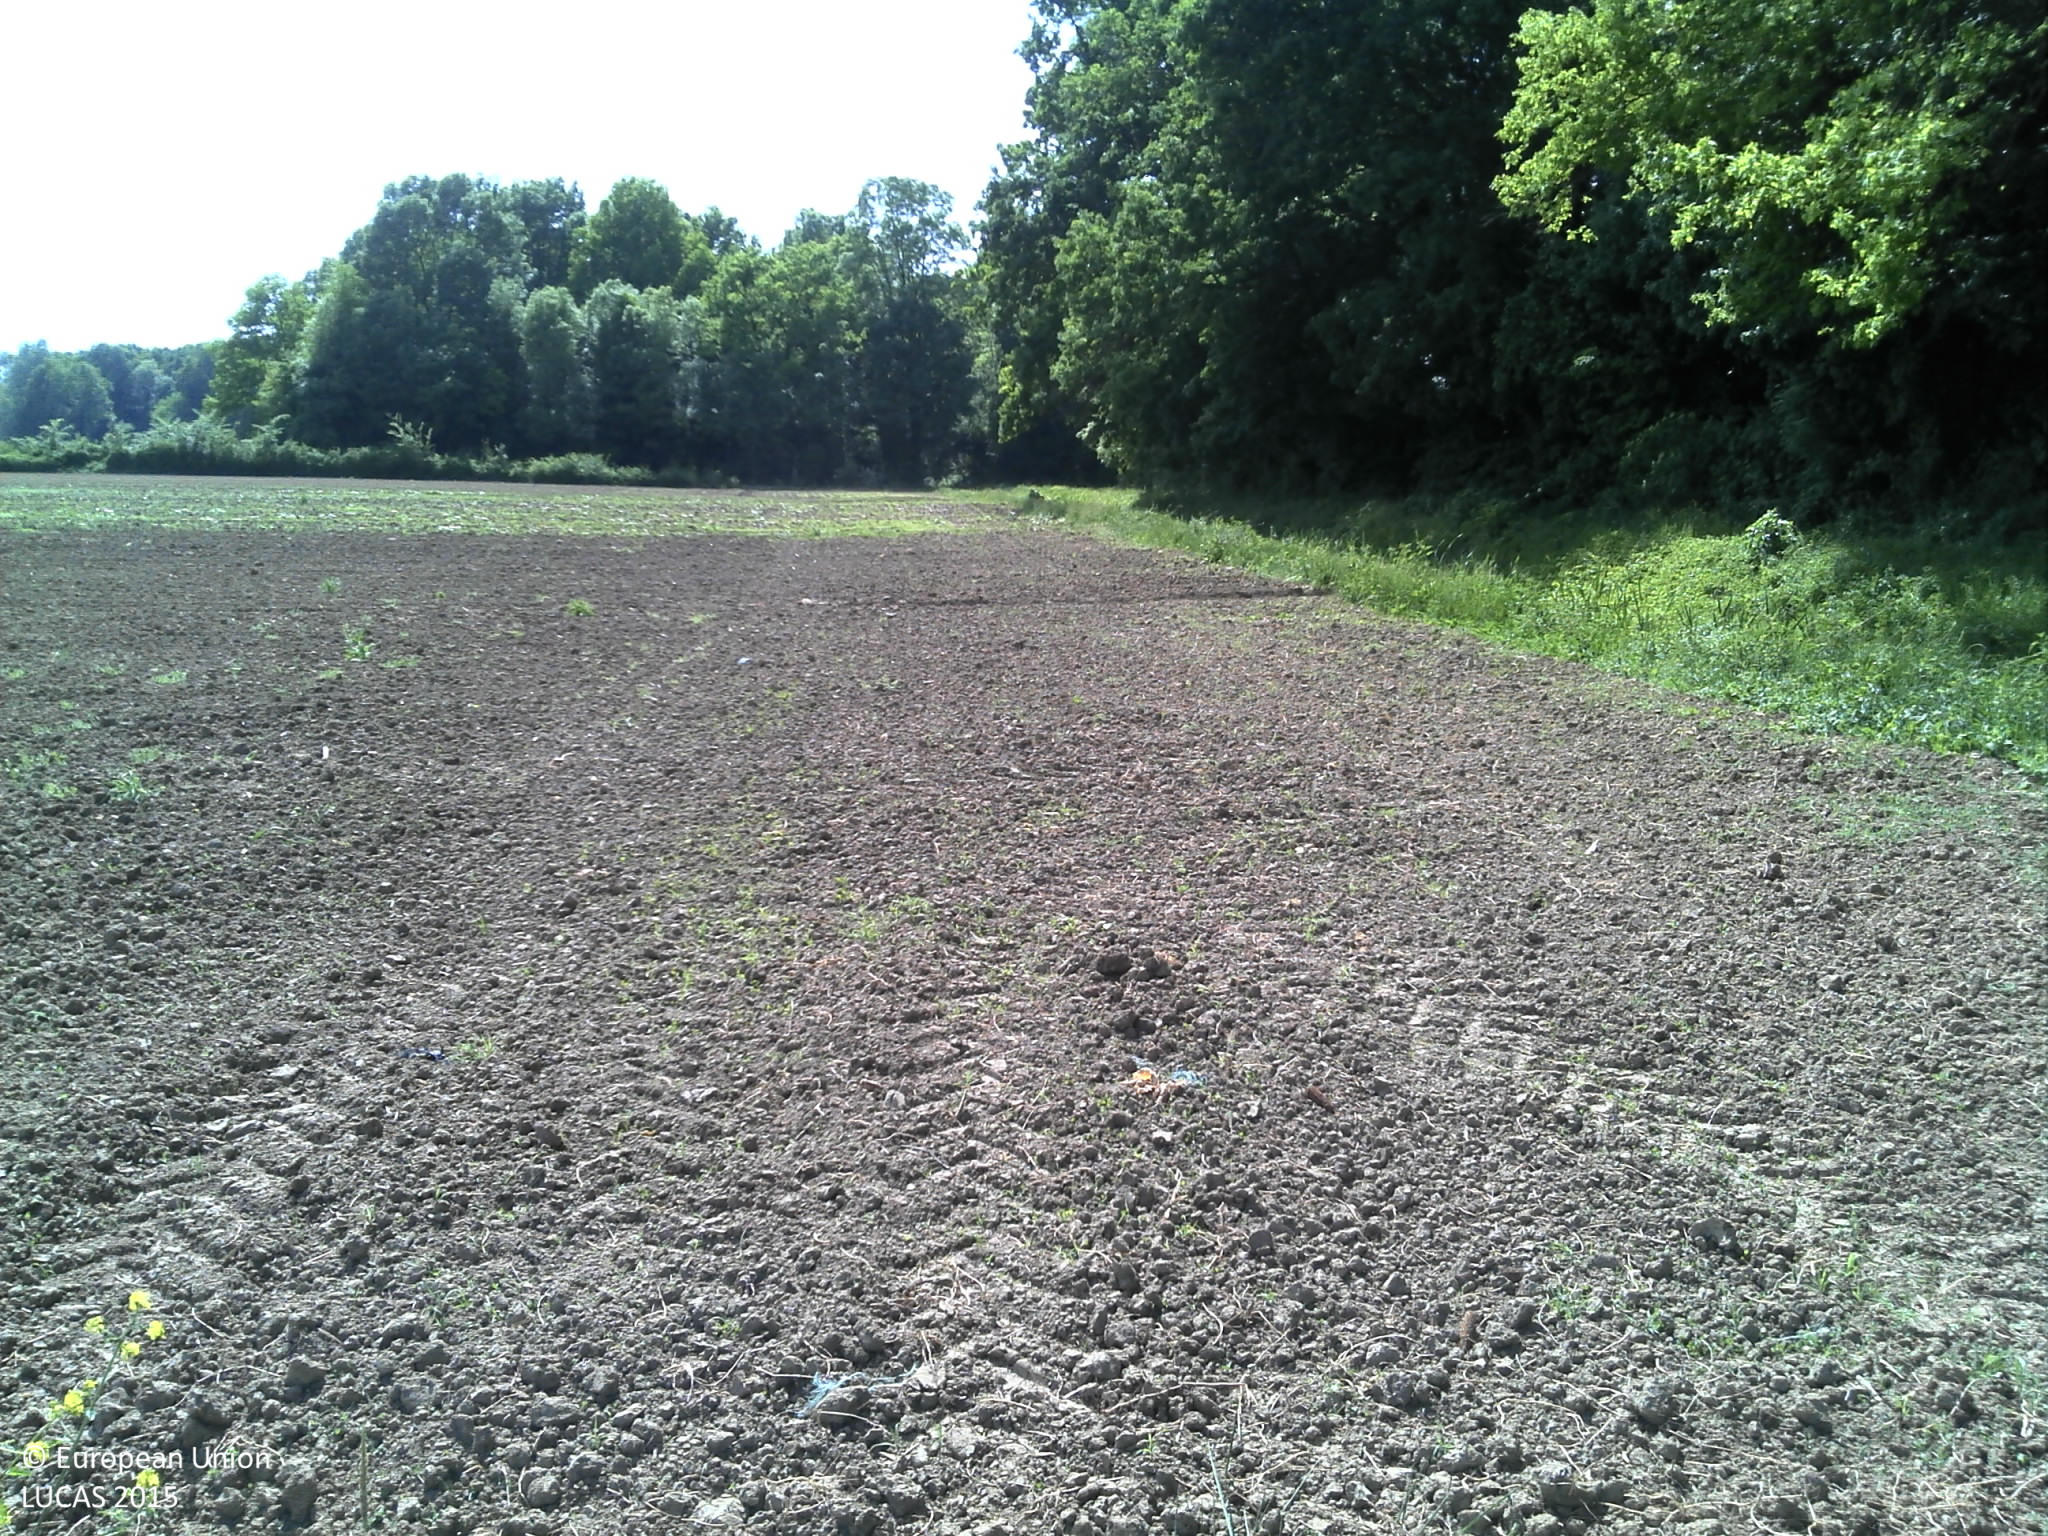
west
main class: Cropland
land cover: Common wheat
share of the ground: > 75 %
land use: Agriculture (excluding fallow land and kitchen gardens)
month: May
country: HR
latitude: 45.1640
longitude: 18.4650
